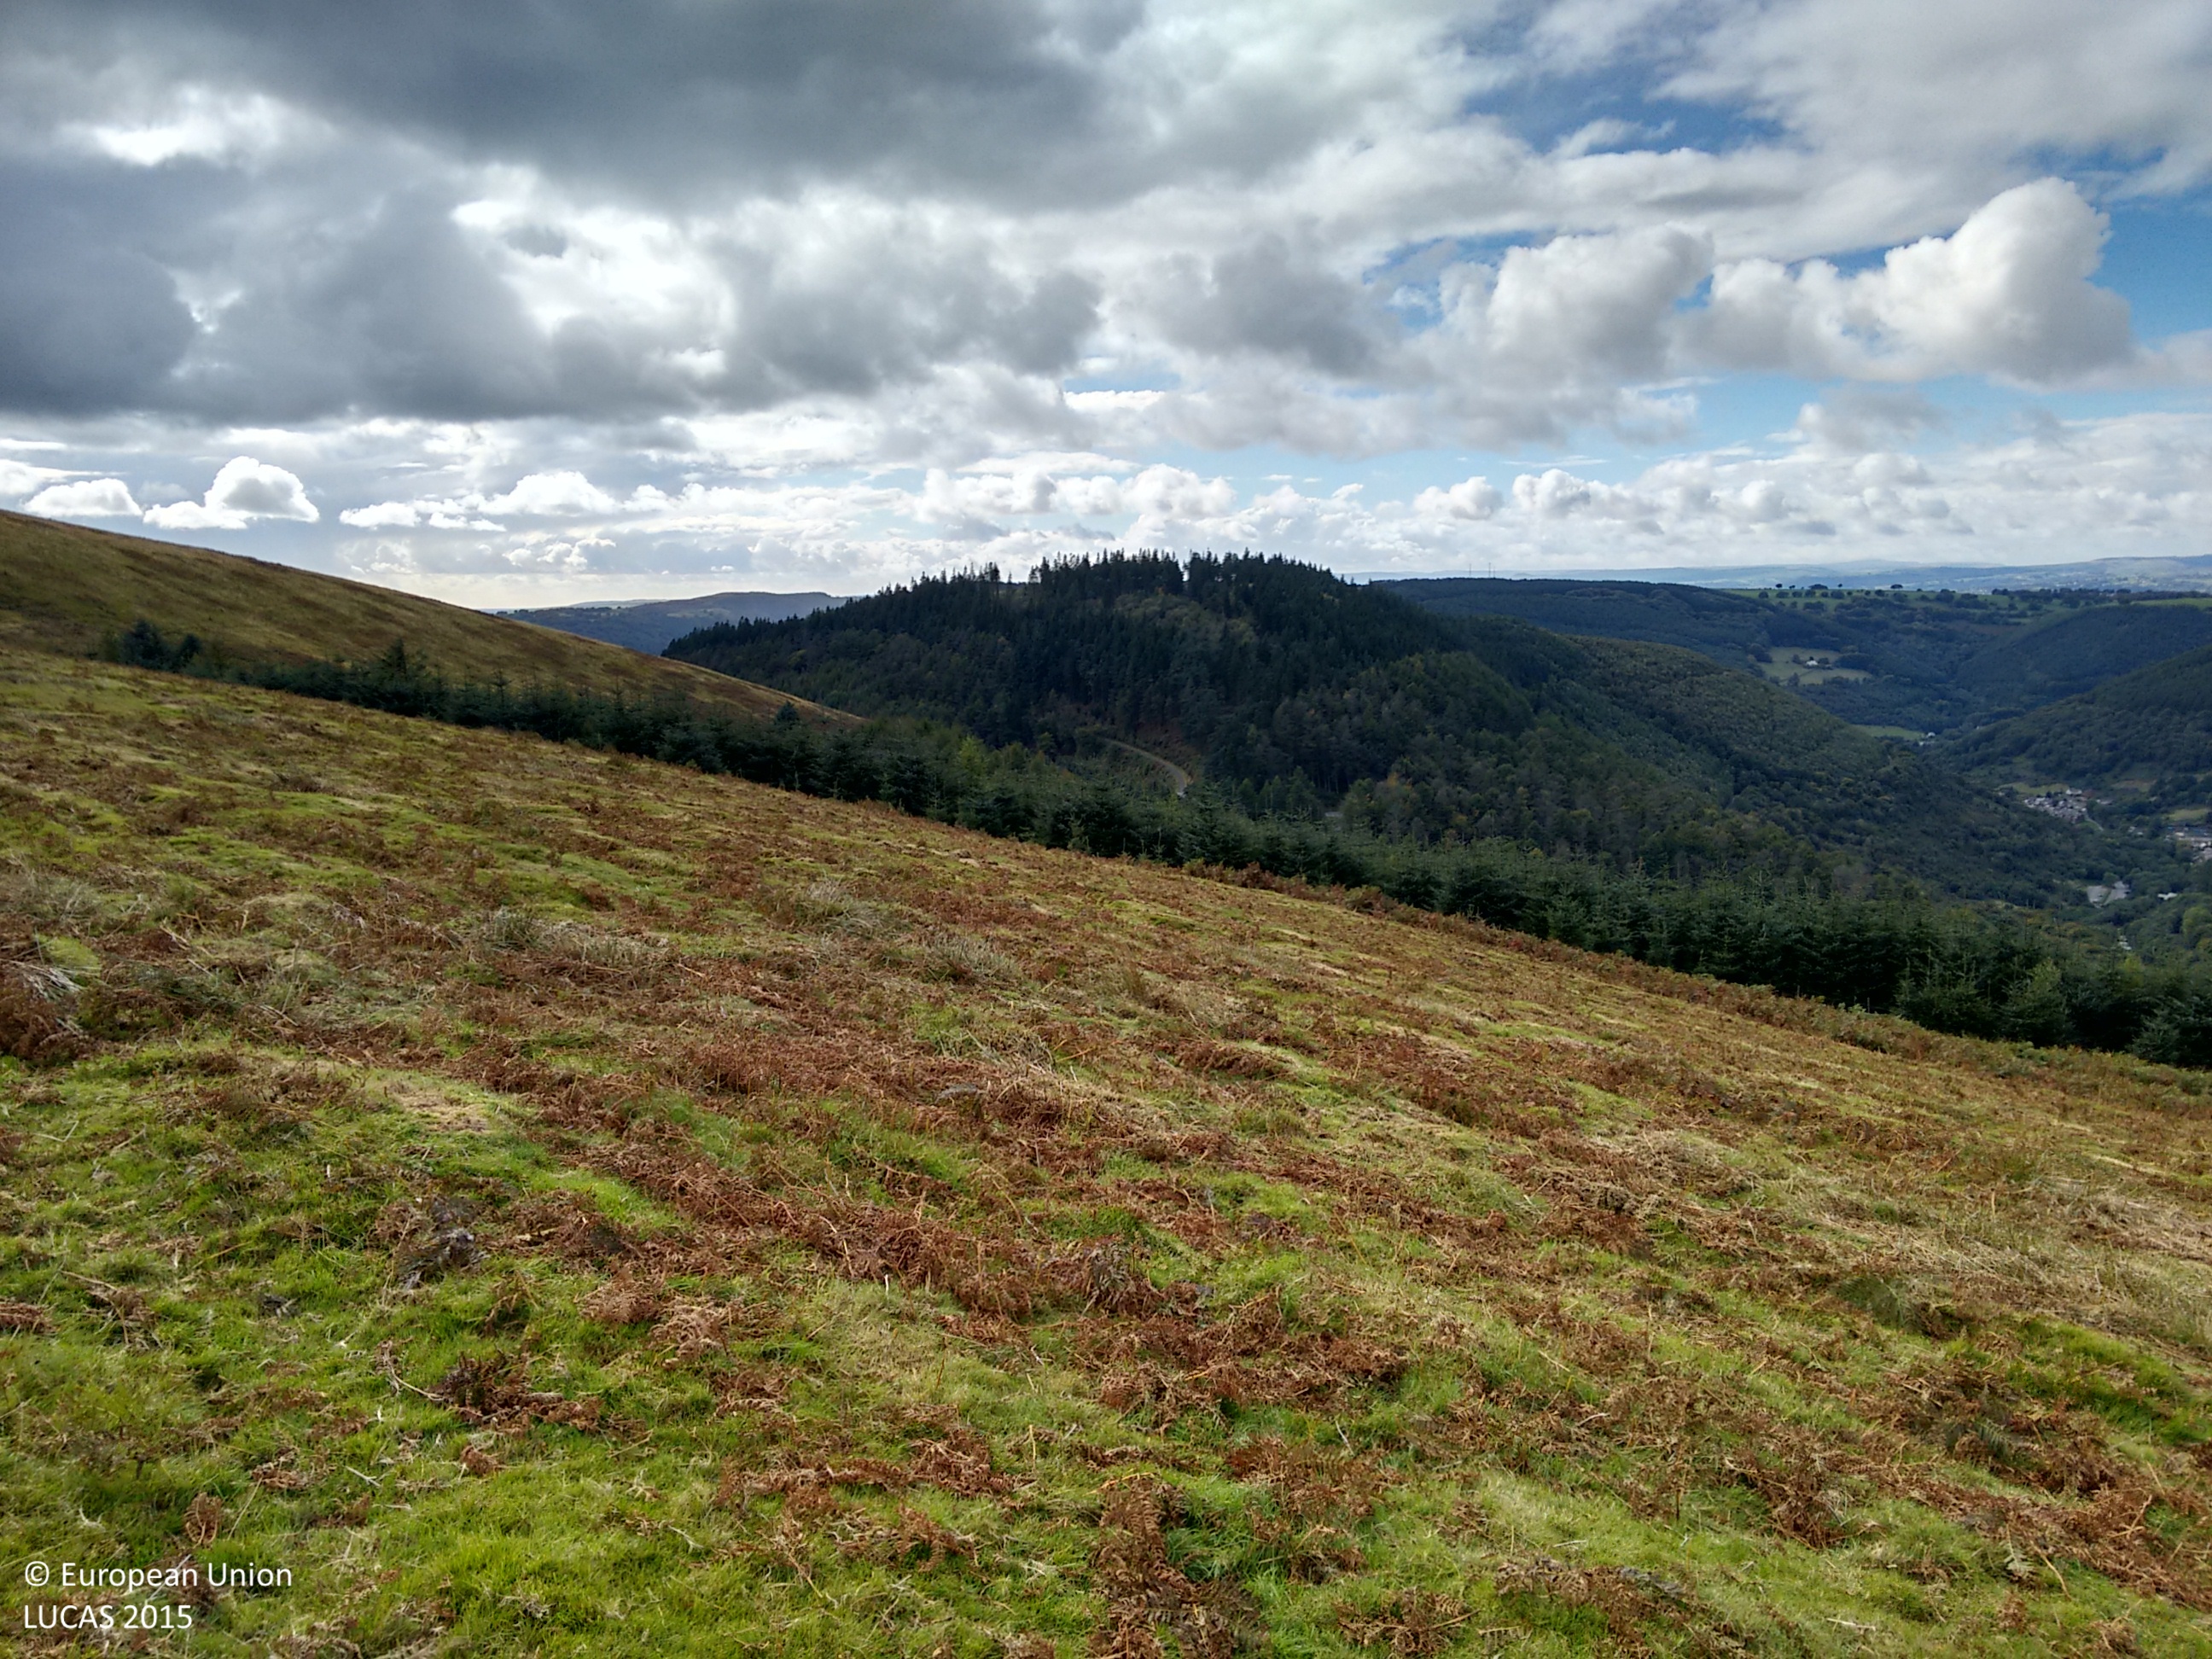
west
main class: Grassland
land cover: Grassland without tree/shrub cover
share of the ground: > 75 %
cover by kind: herbaceous plants 100 %
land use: Agriculture (excluding fallow land and kitchen gardens)
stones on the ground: < 10 %
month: September
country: GB
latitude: 51.6300
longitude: -3.0933
